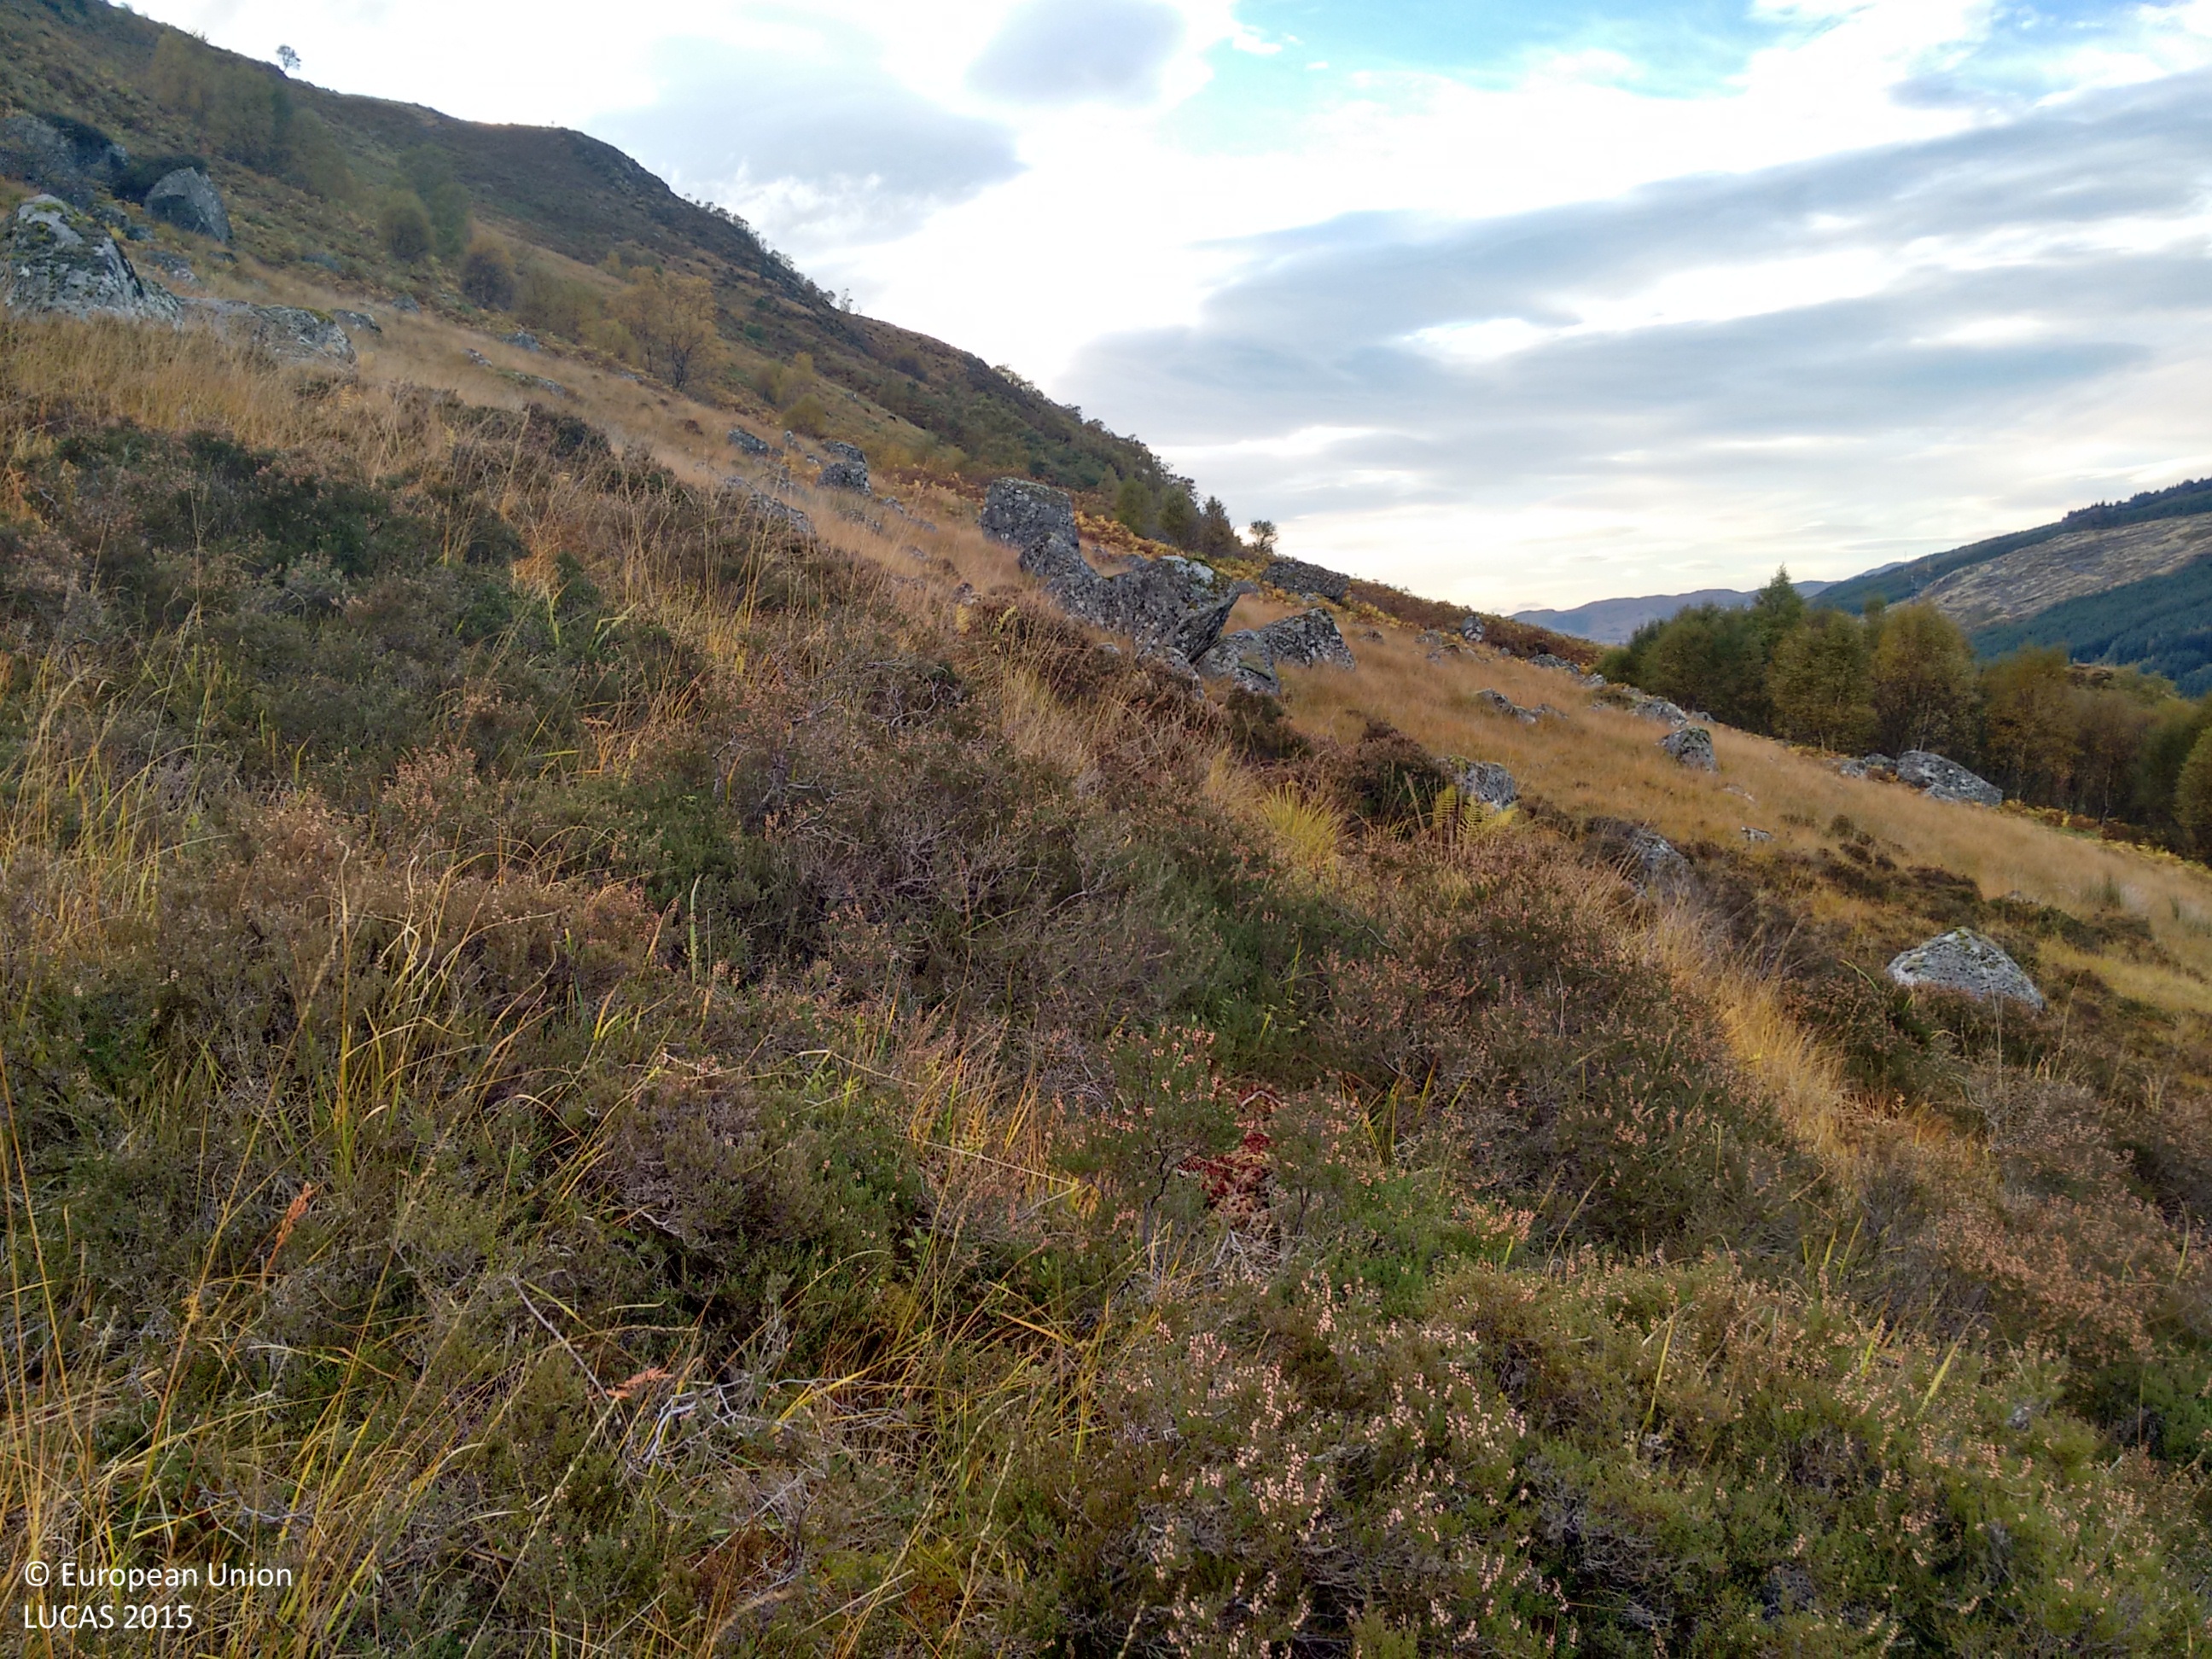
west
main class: Shrubland
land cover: Shrubland without tree cover
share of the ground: > 75 %
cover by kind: shrubs 60 %, herbaceous plants 30 %, lichens and mosses 5 %
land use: Agriculture (excluding fallow land and kitchen gardens)
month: October
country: GB
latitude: 56.6857
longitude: -5.5144
